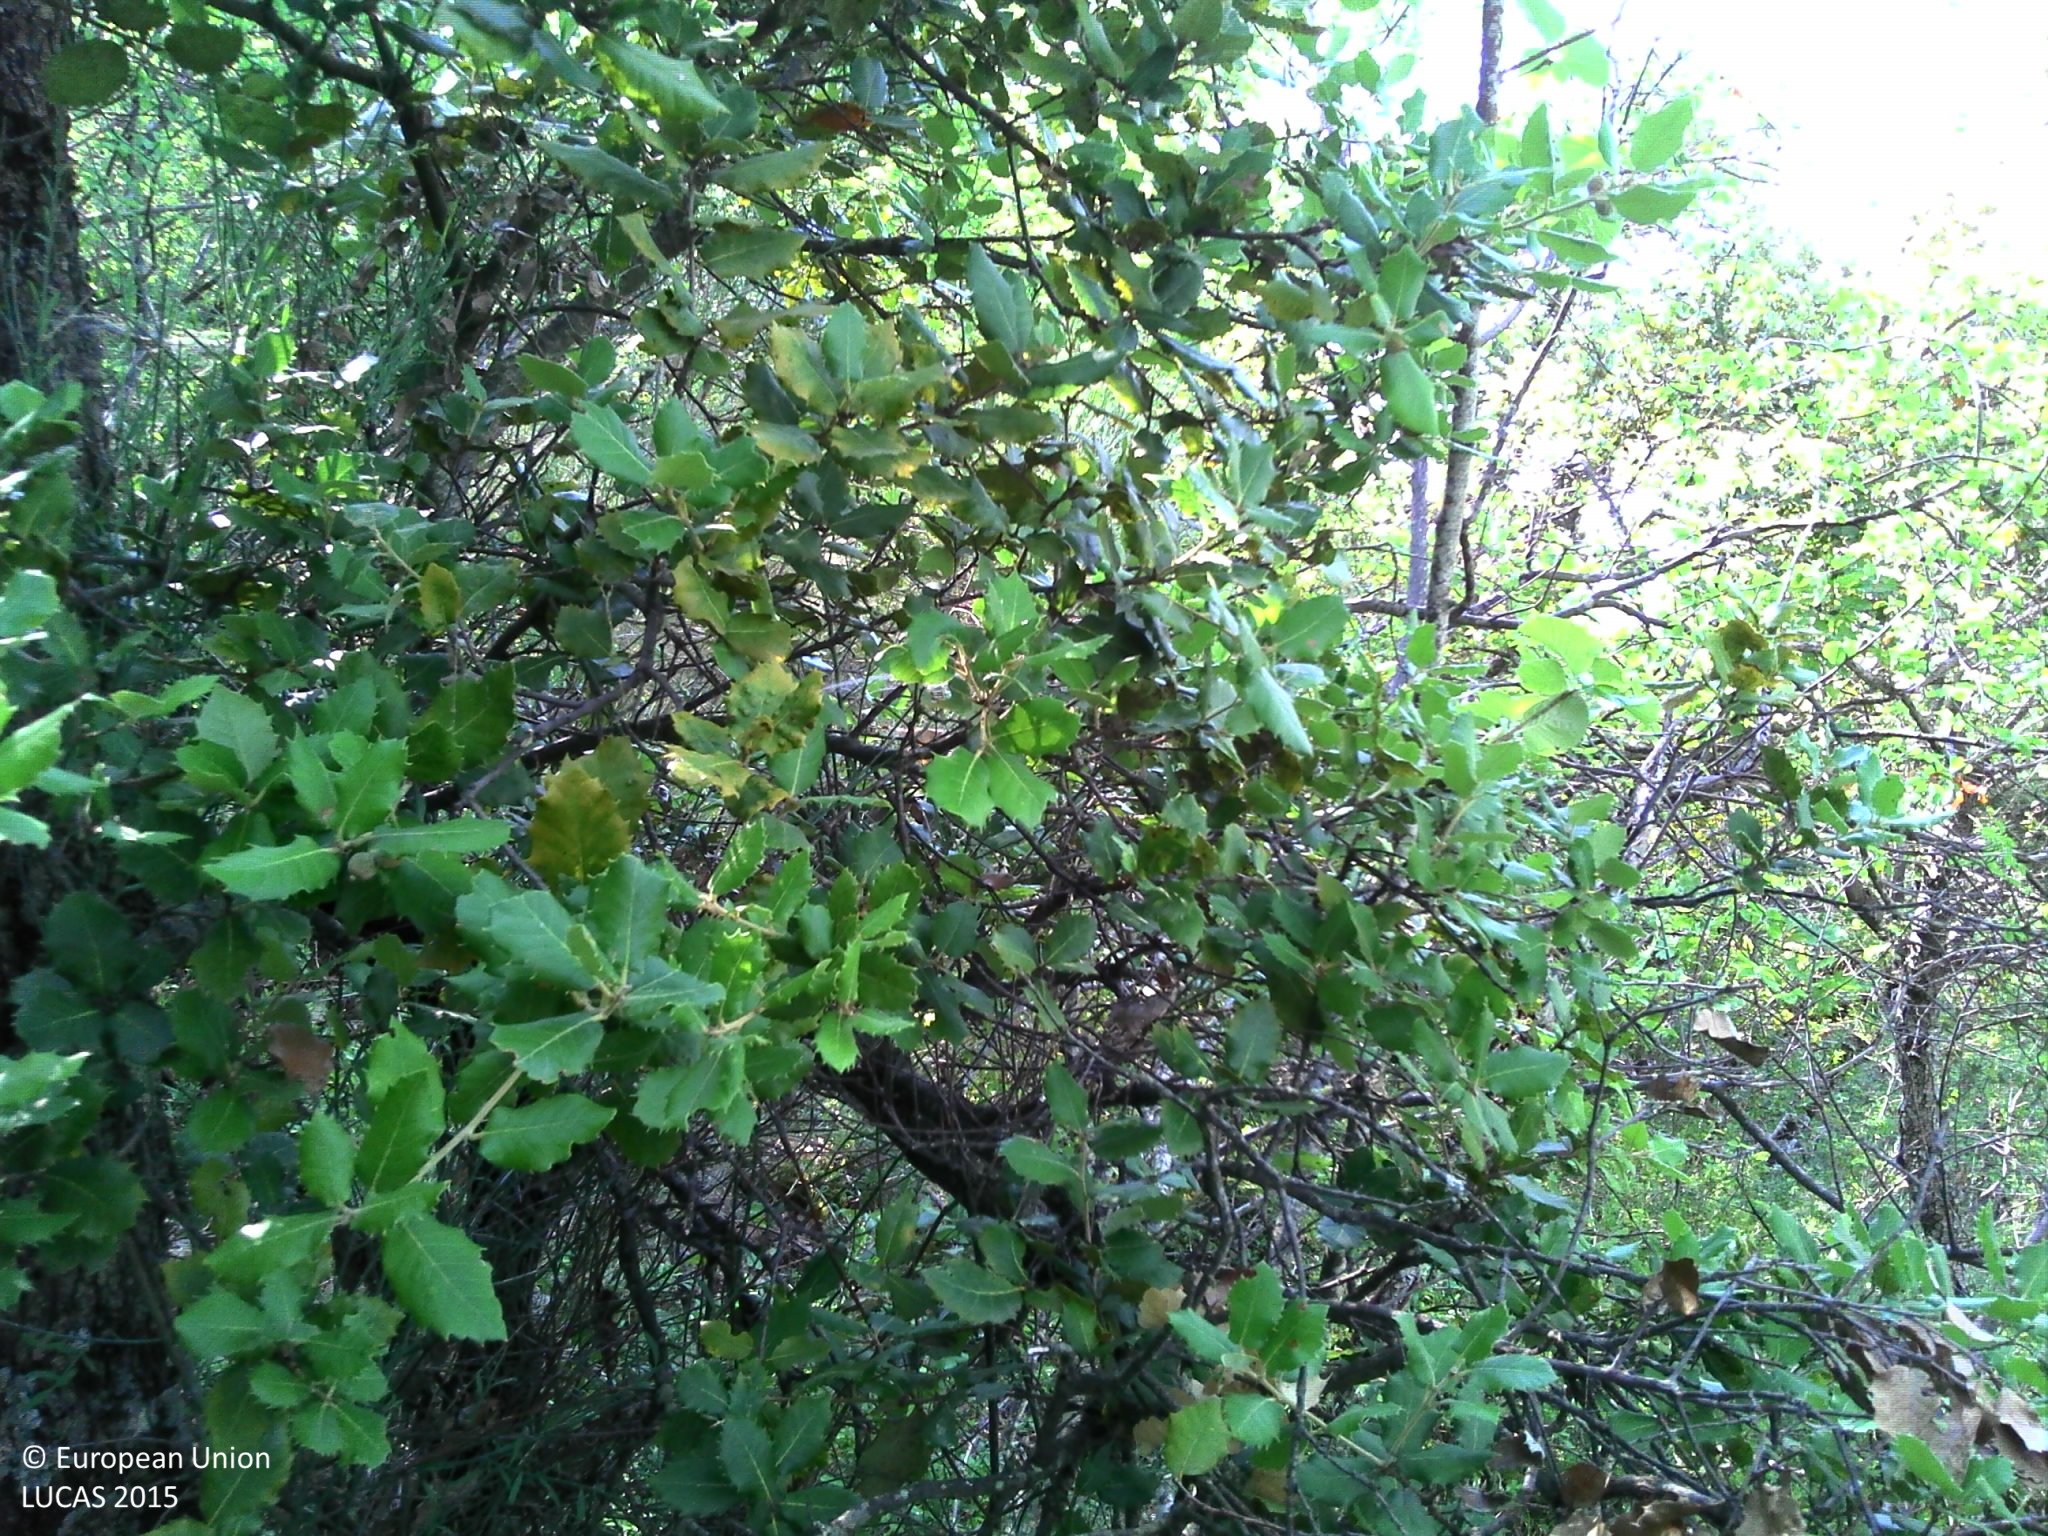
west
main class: Woodland
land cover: Broadleaved woodland
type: broadleaved evergreen forest
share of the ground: > 75 %
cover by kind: broadleaved forest trees 75 %, shrubs 15 %, herbaceous plants 5 %, unconsolidated bare surface 5 %
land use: Semi-natural and natural areas not in use
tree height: < 5 m
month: August
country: FR
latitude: 43.8497
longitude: 5.3688
